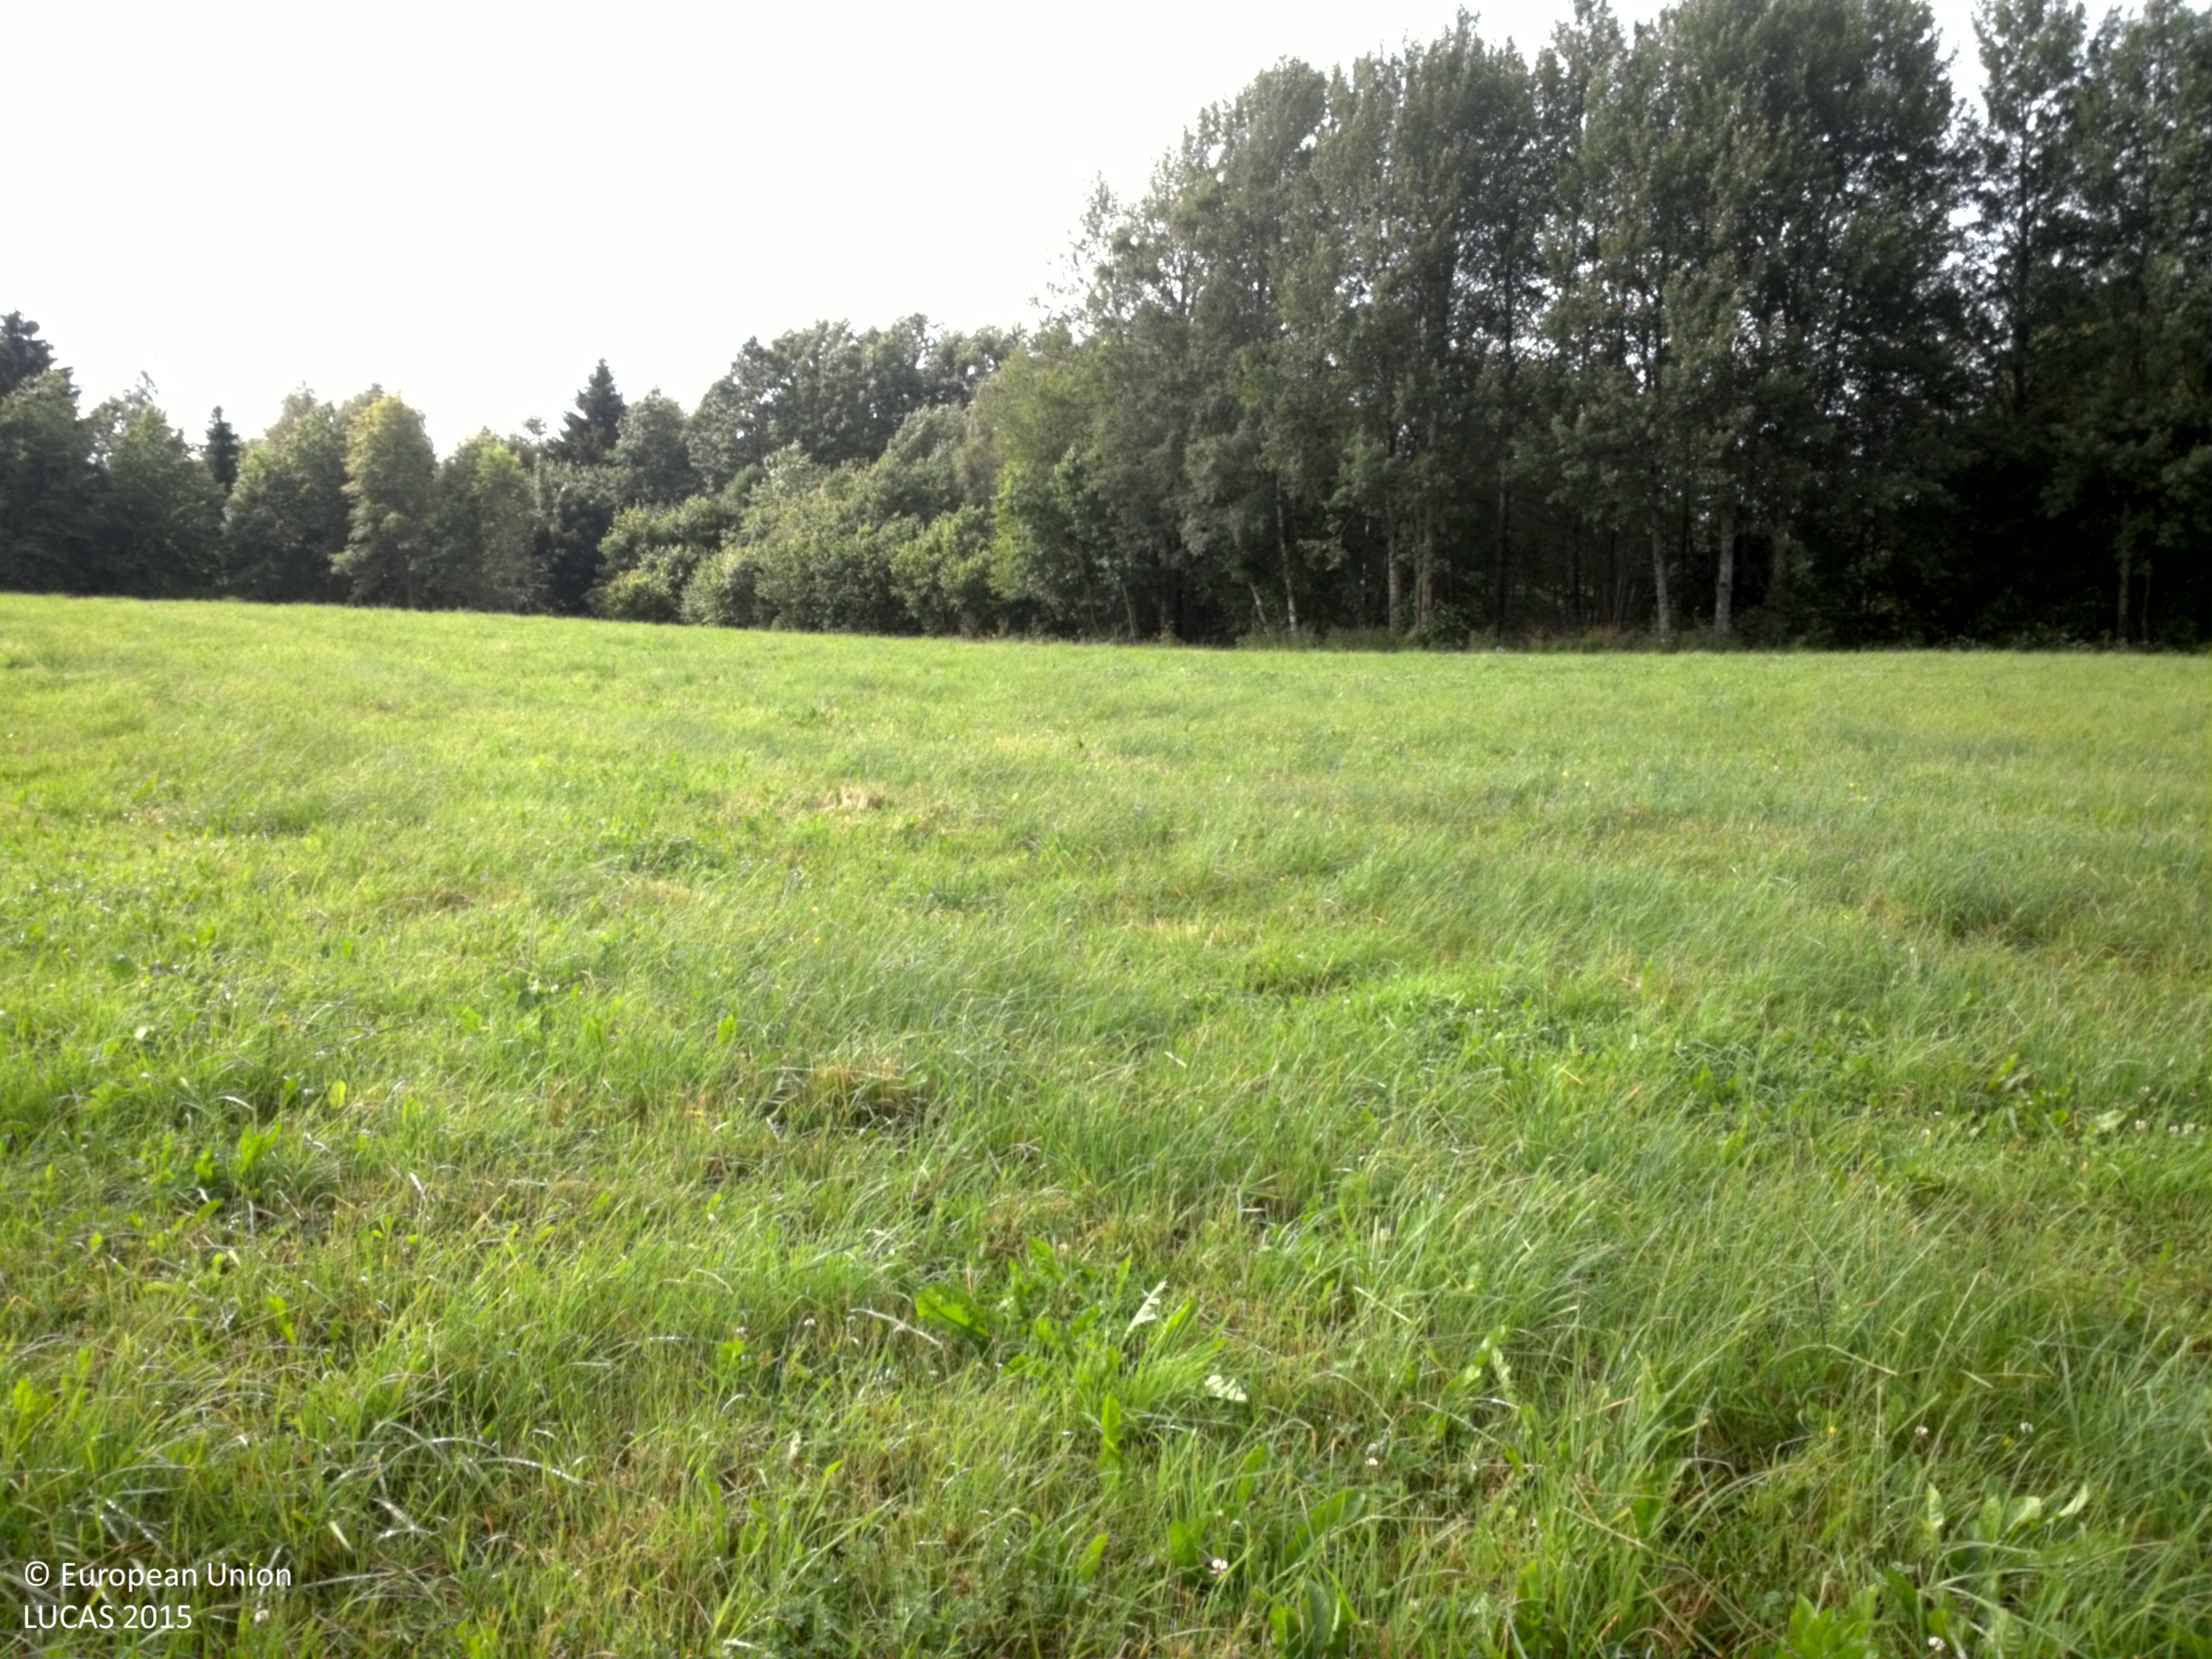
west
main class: Grassland
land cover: Grassland without tree/shrub cover
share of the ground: > 75 %
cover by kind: herbaceous plants 100 %
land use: Agriculture (excluding fallow land and kitchen gardens)
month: July
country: SE
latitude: 57.7763
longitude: 14.7201
